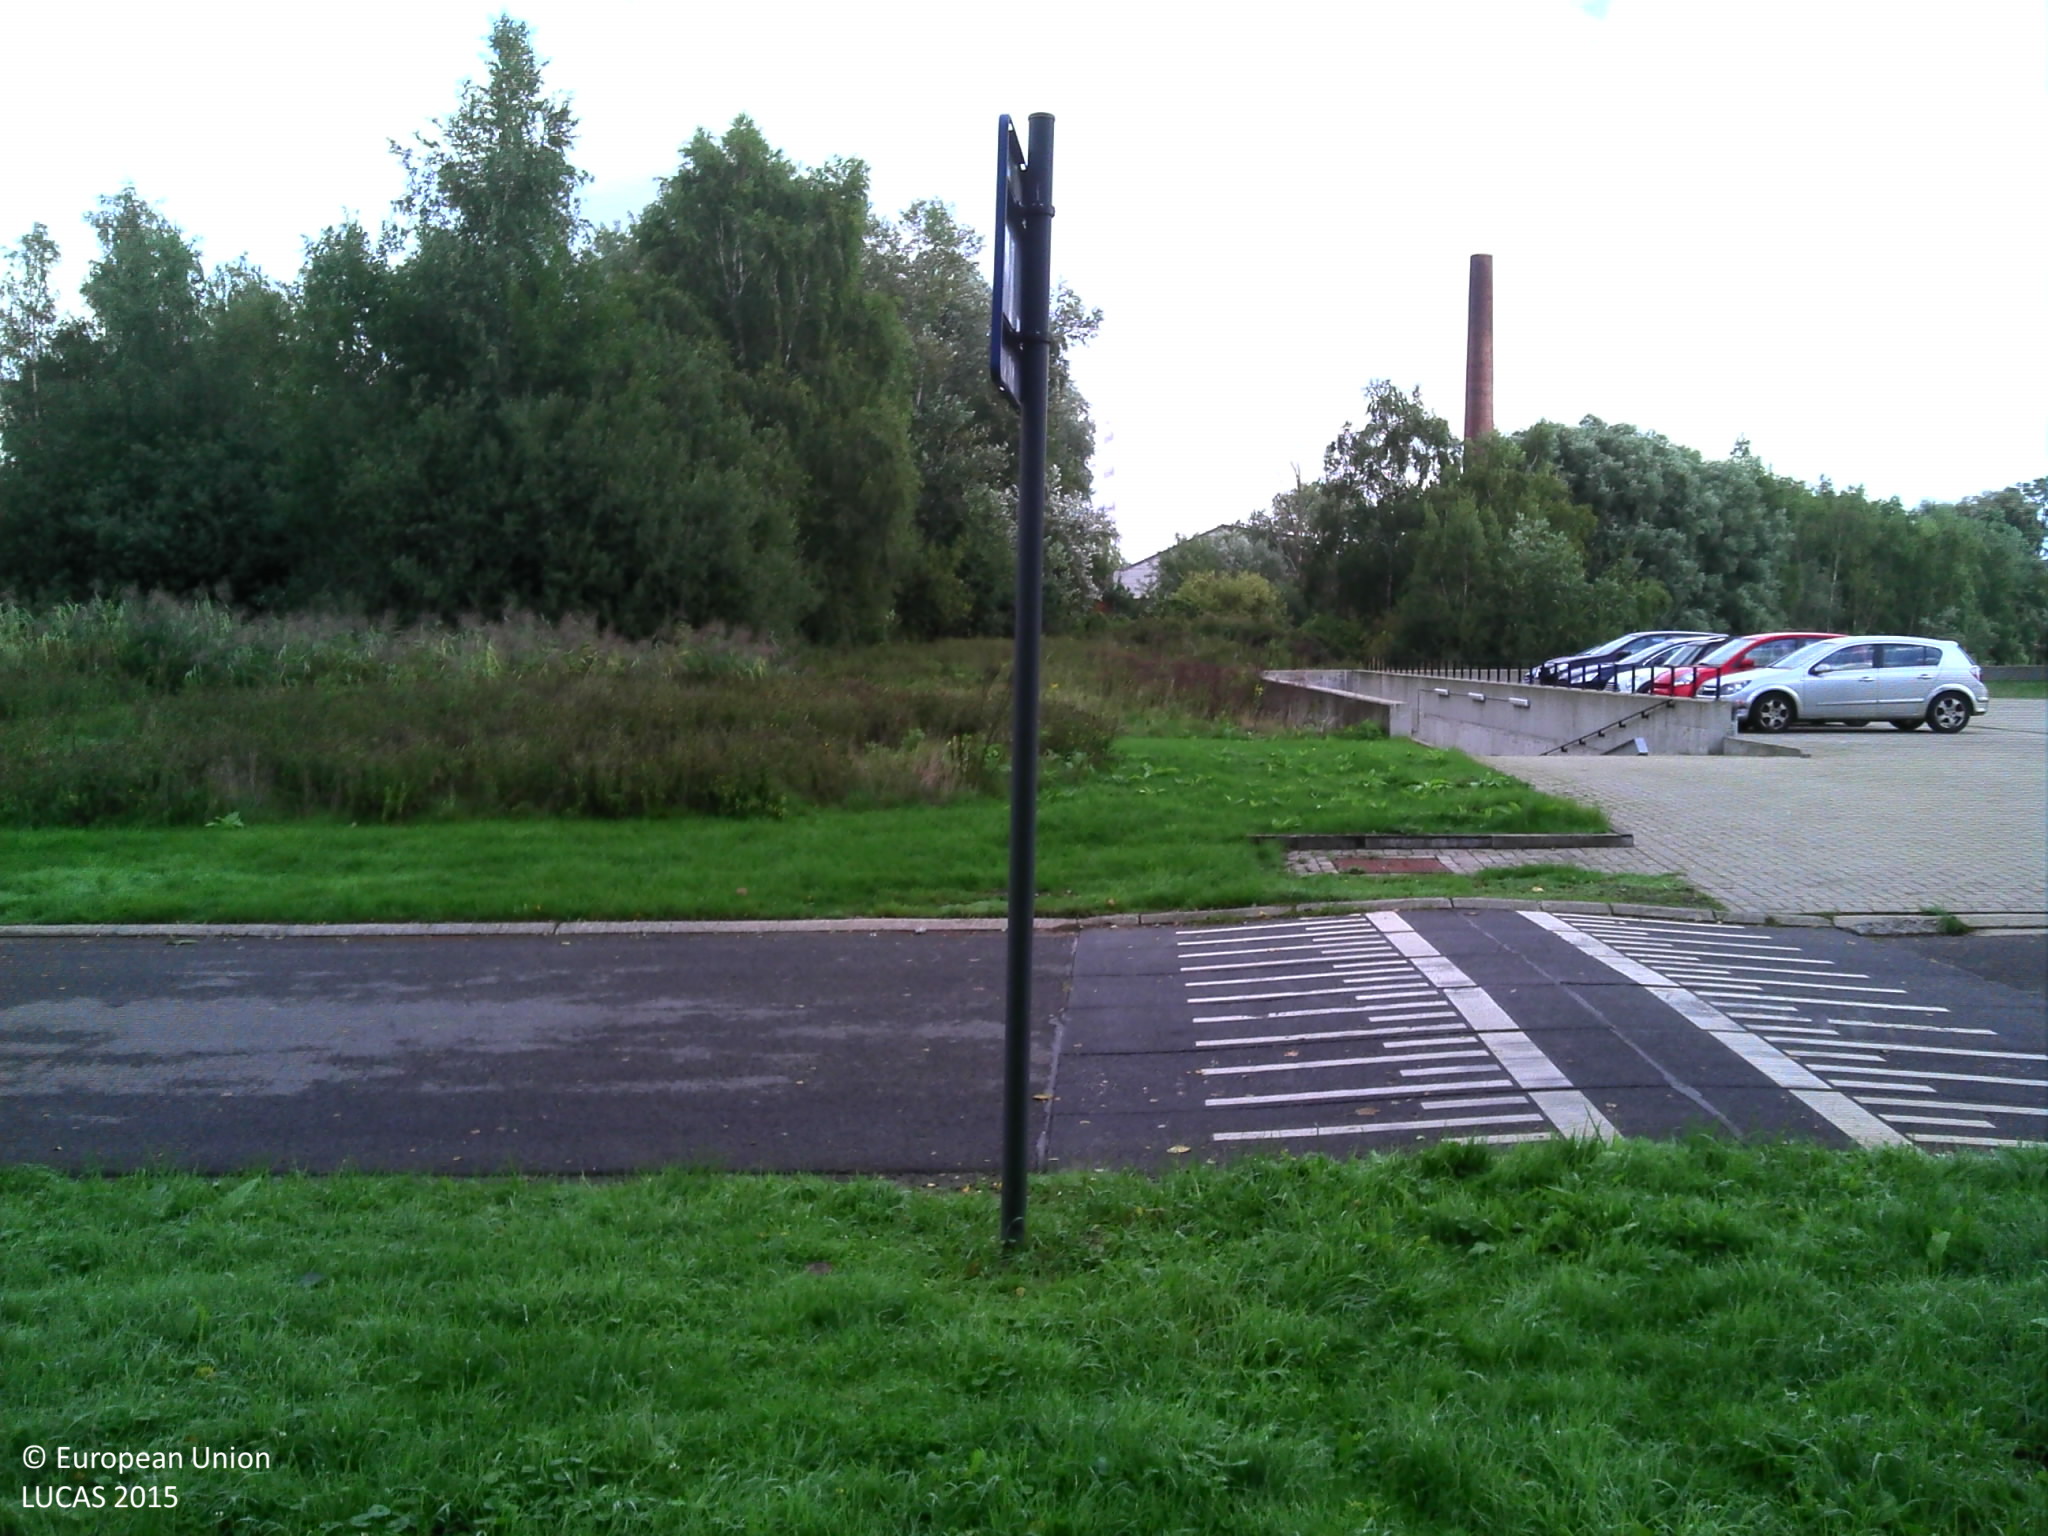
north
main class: Grassland
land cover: Grassland without tree/shrub cover
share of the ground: > 75 %
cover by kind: herbaceous plants 100 %
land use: Road transport
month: September
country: BE
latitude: 51.1078
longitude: 4.3536
